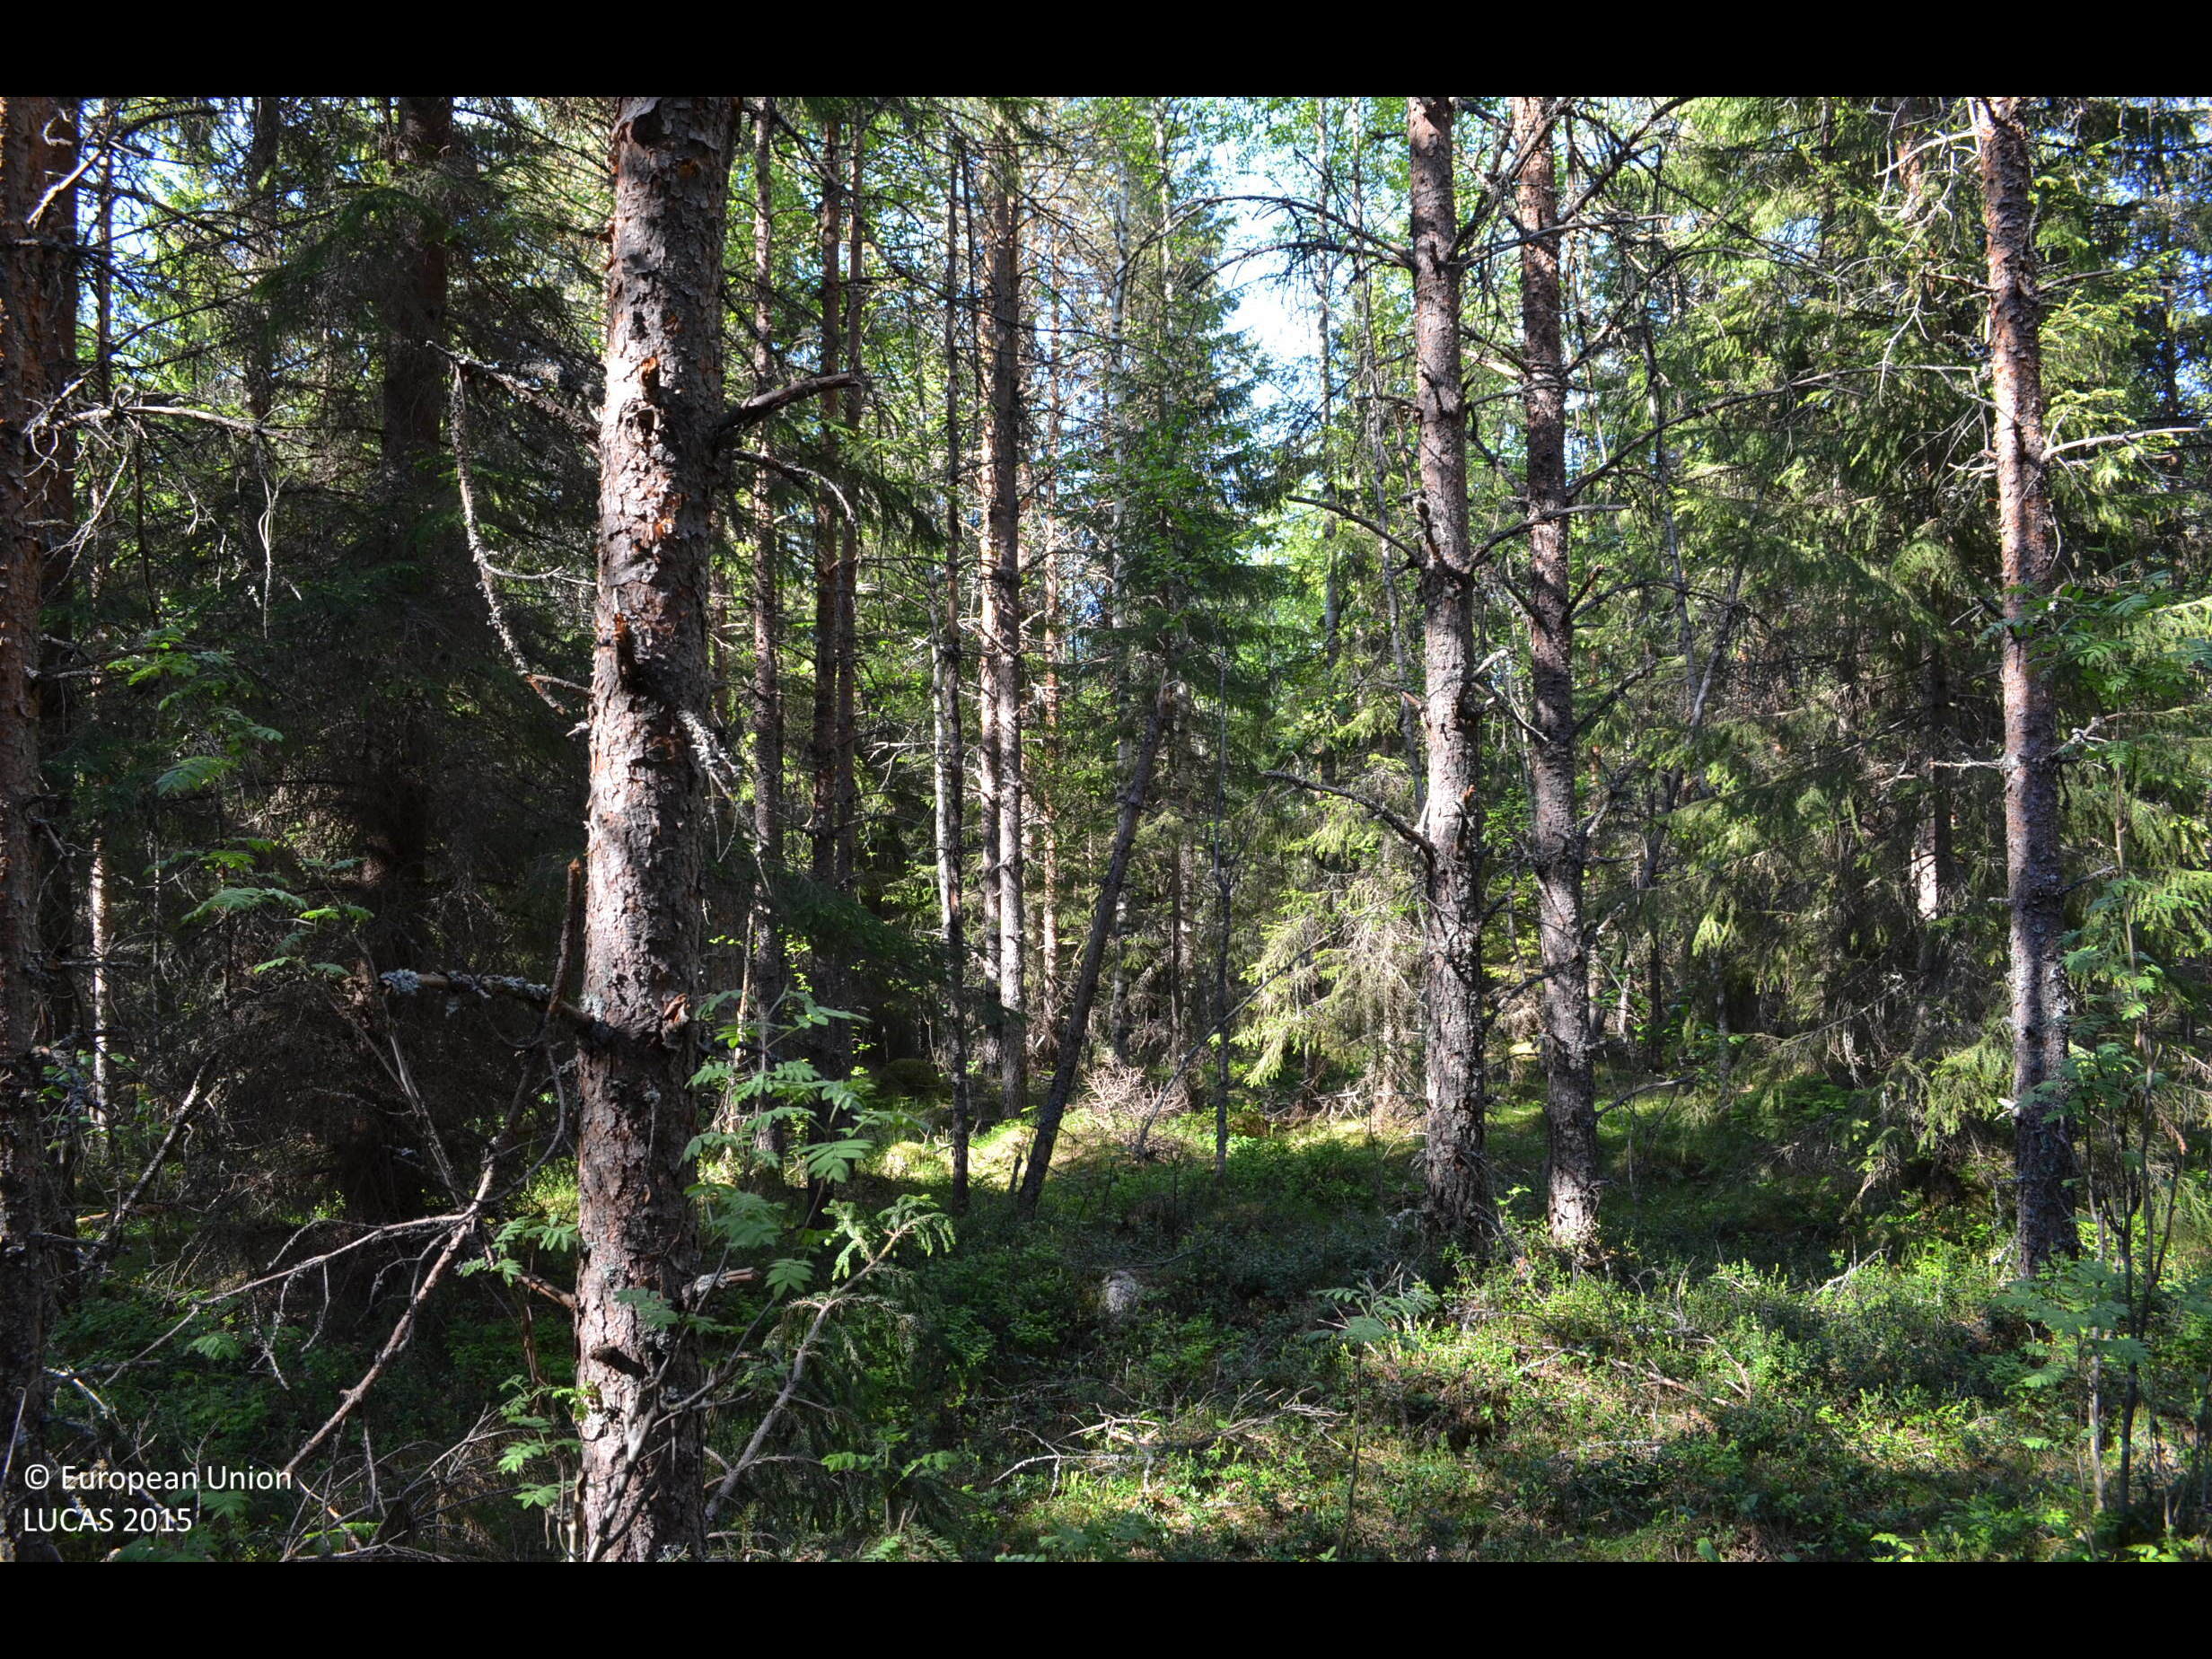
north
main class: Woodland
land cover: Pine dominated coniferous woodland
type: boreal forest
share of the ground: > 75 %
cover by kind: coniferous forest trees 80 %, shrubs 15 %, broadleaved forest trees 5 %
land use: Forestry
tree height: > 5 m
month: June
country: FI
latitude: 61.9121
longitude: 23.2661
